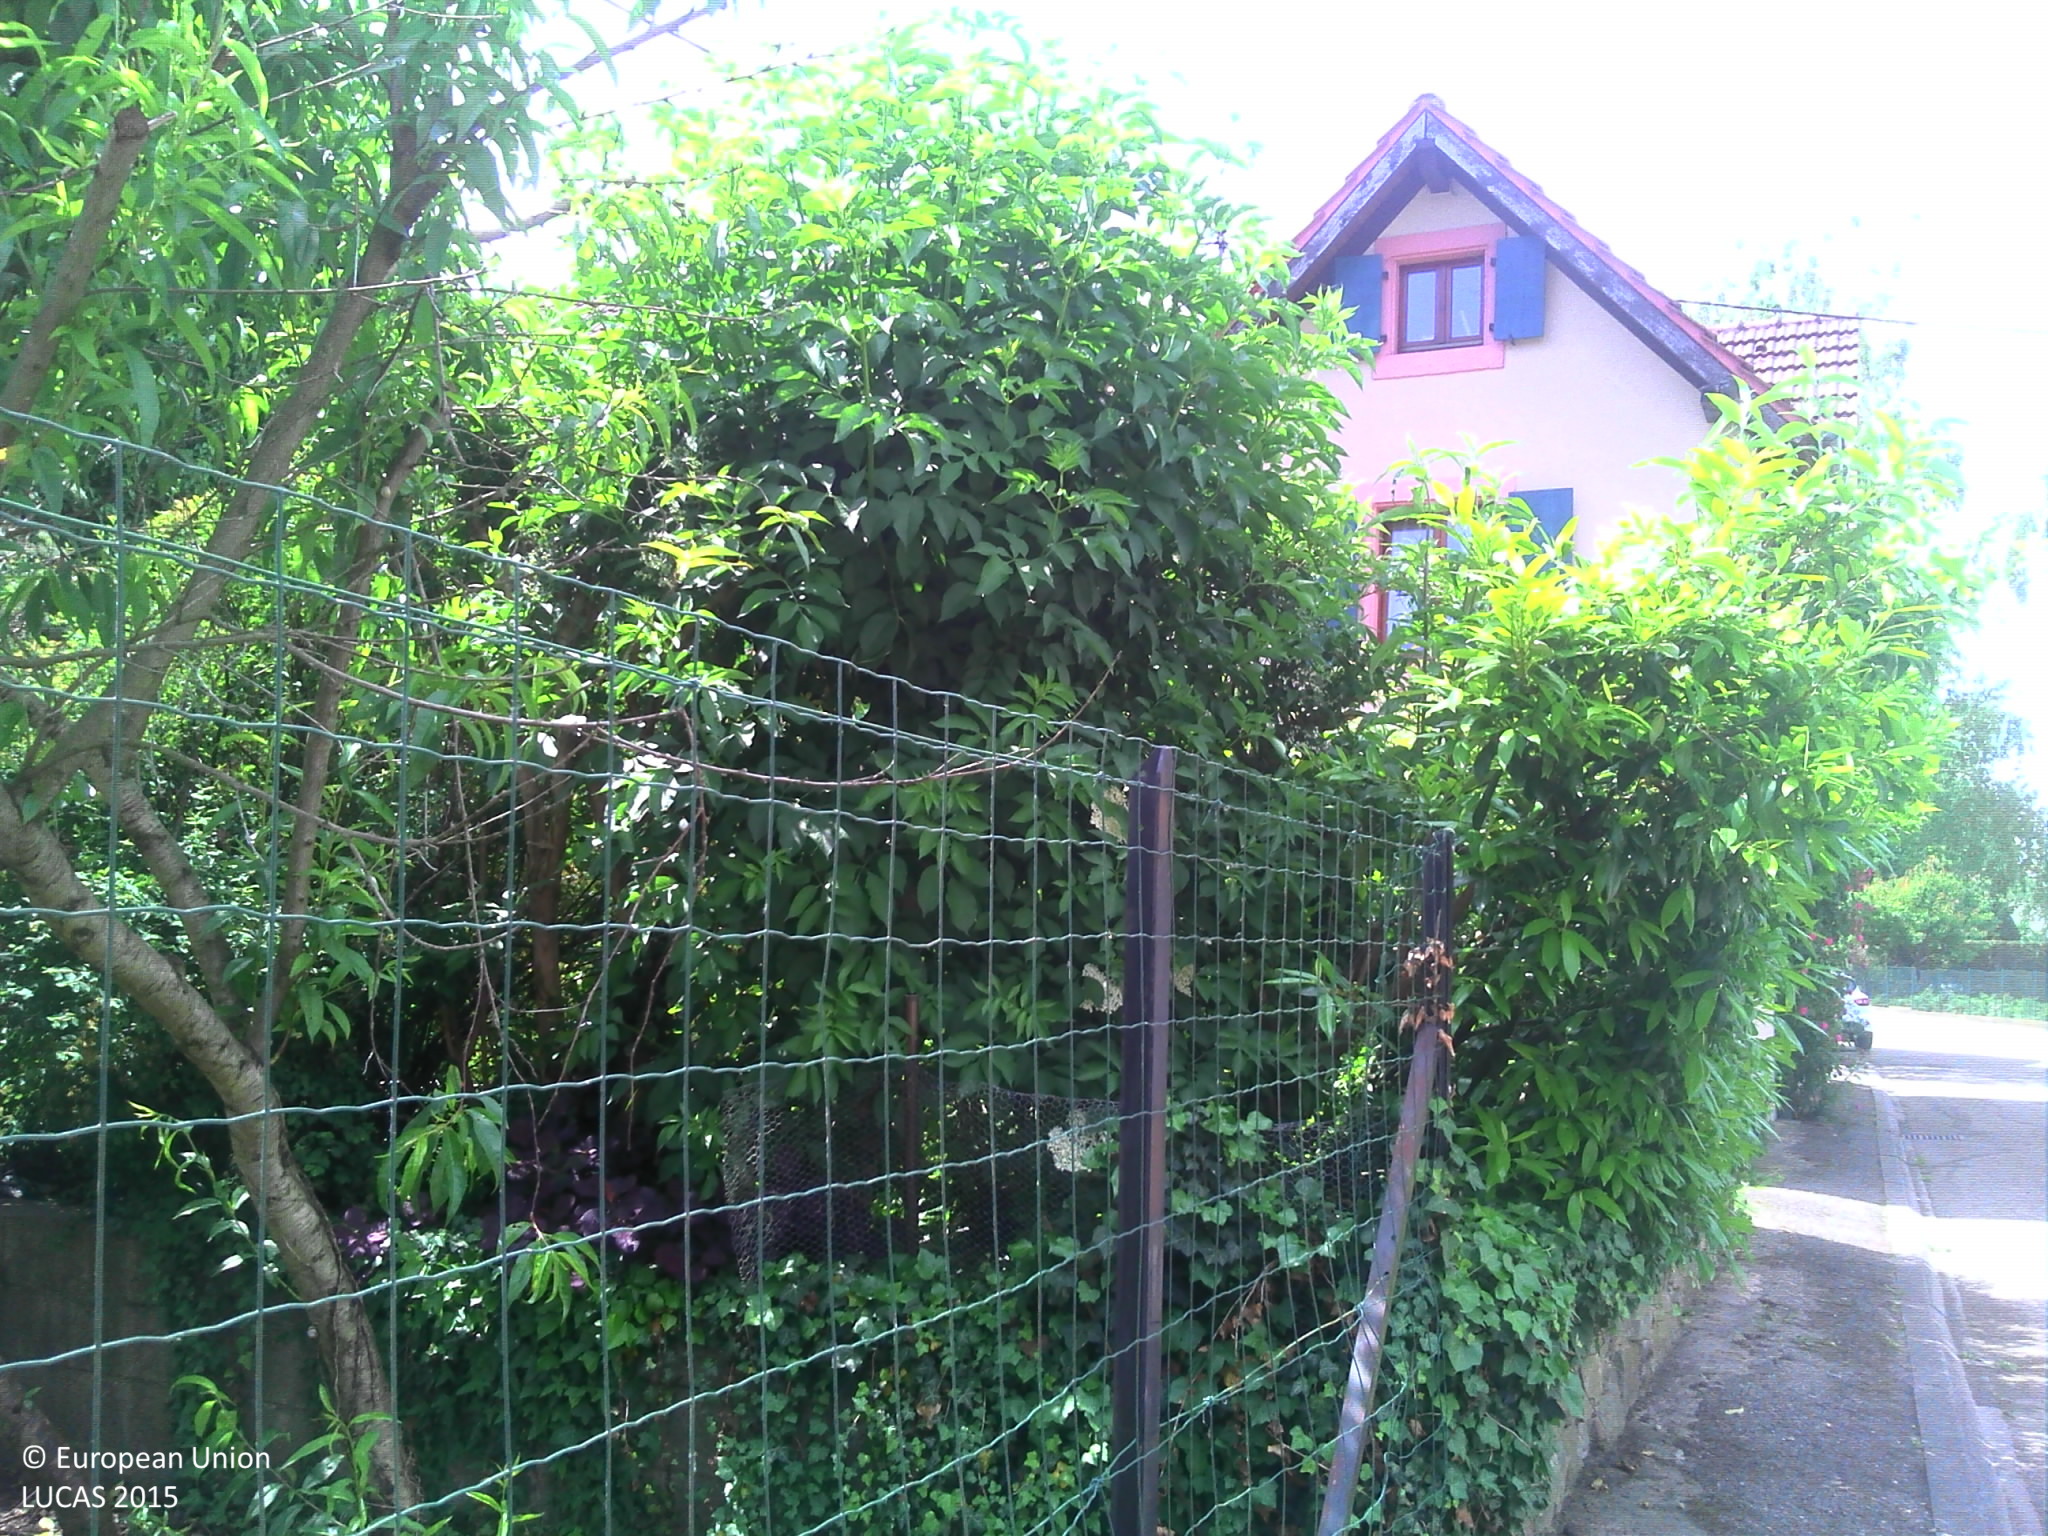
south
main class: Cropland
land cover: Other fresh vegetables
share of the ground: > 75 %
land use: Kitchen garden
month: May
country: FR
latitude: 48.2338
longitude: 7.6180
